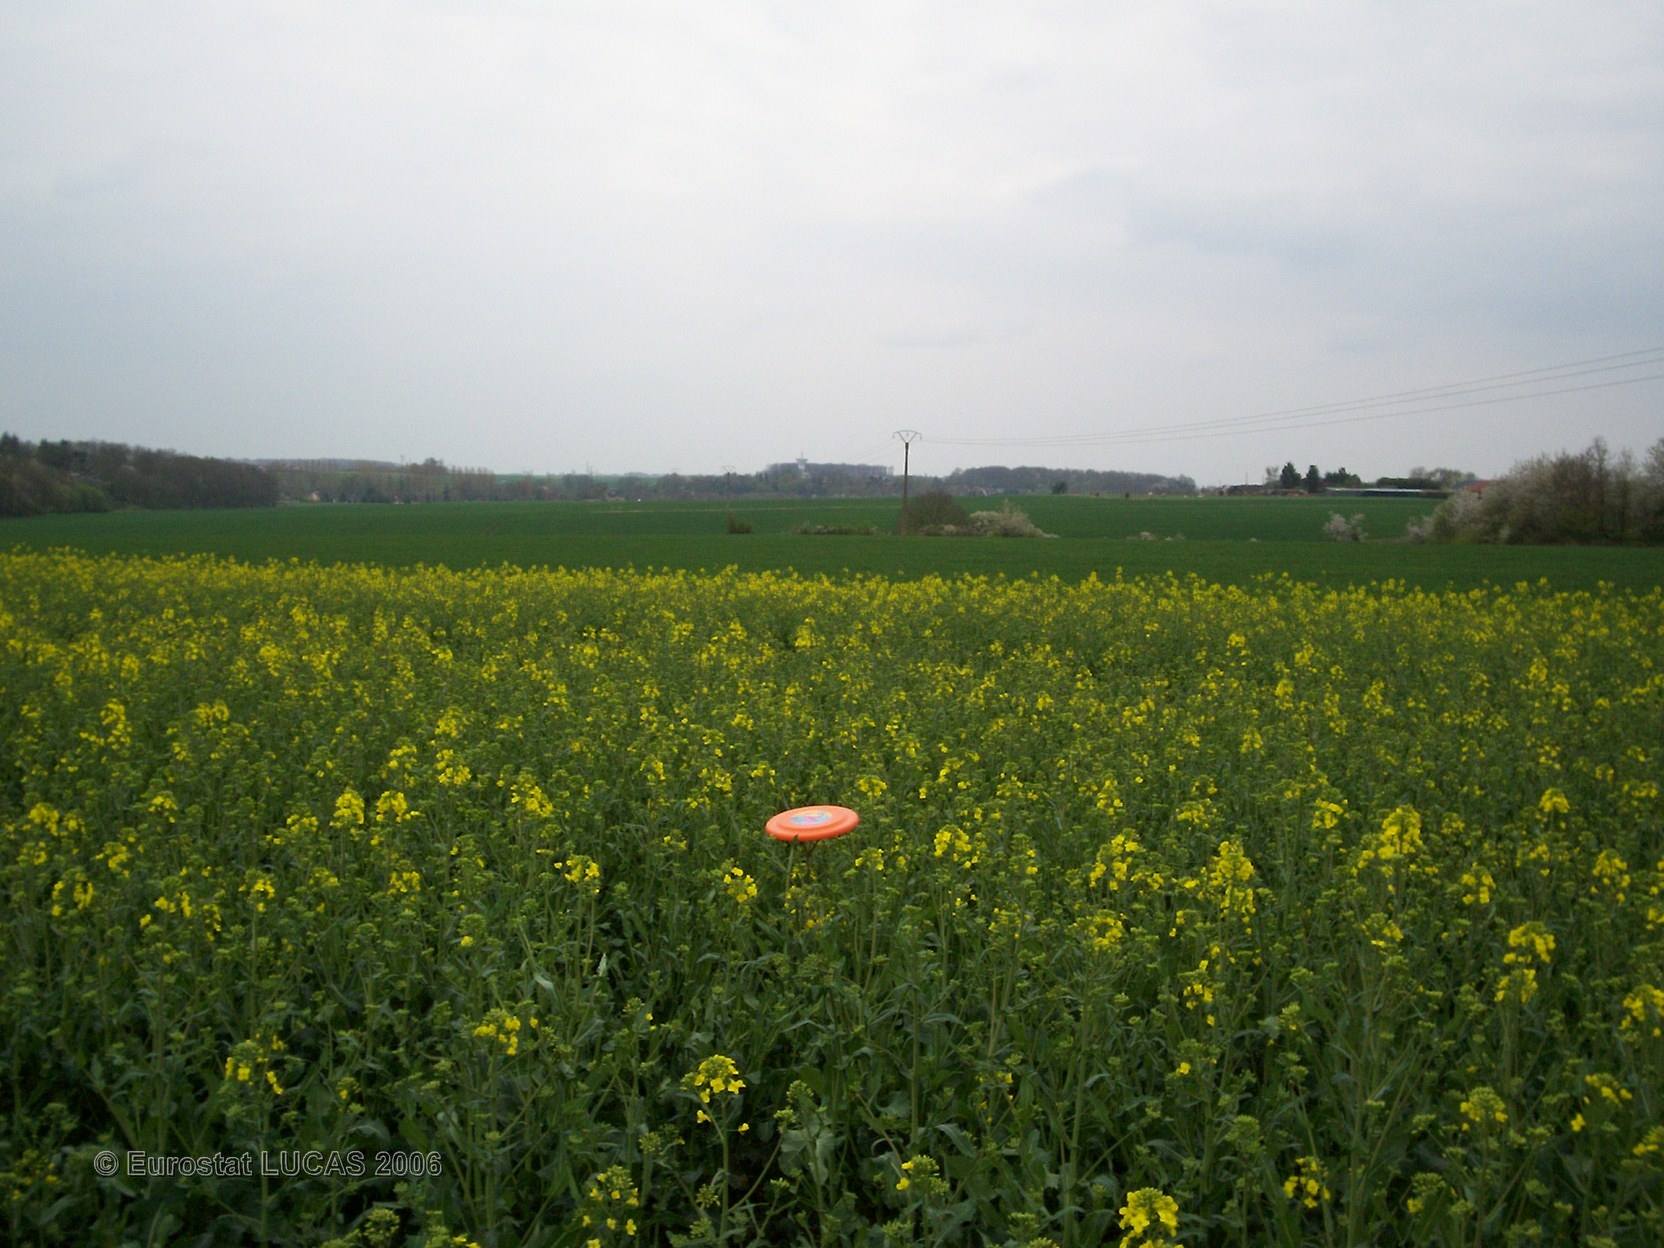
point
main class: Cropland
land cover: Rape and turnip rape
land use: Agriculture (excluding fallow land and kitchen gardens)
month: April
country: FR
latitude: 48.8725
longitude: 1.0487
